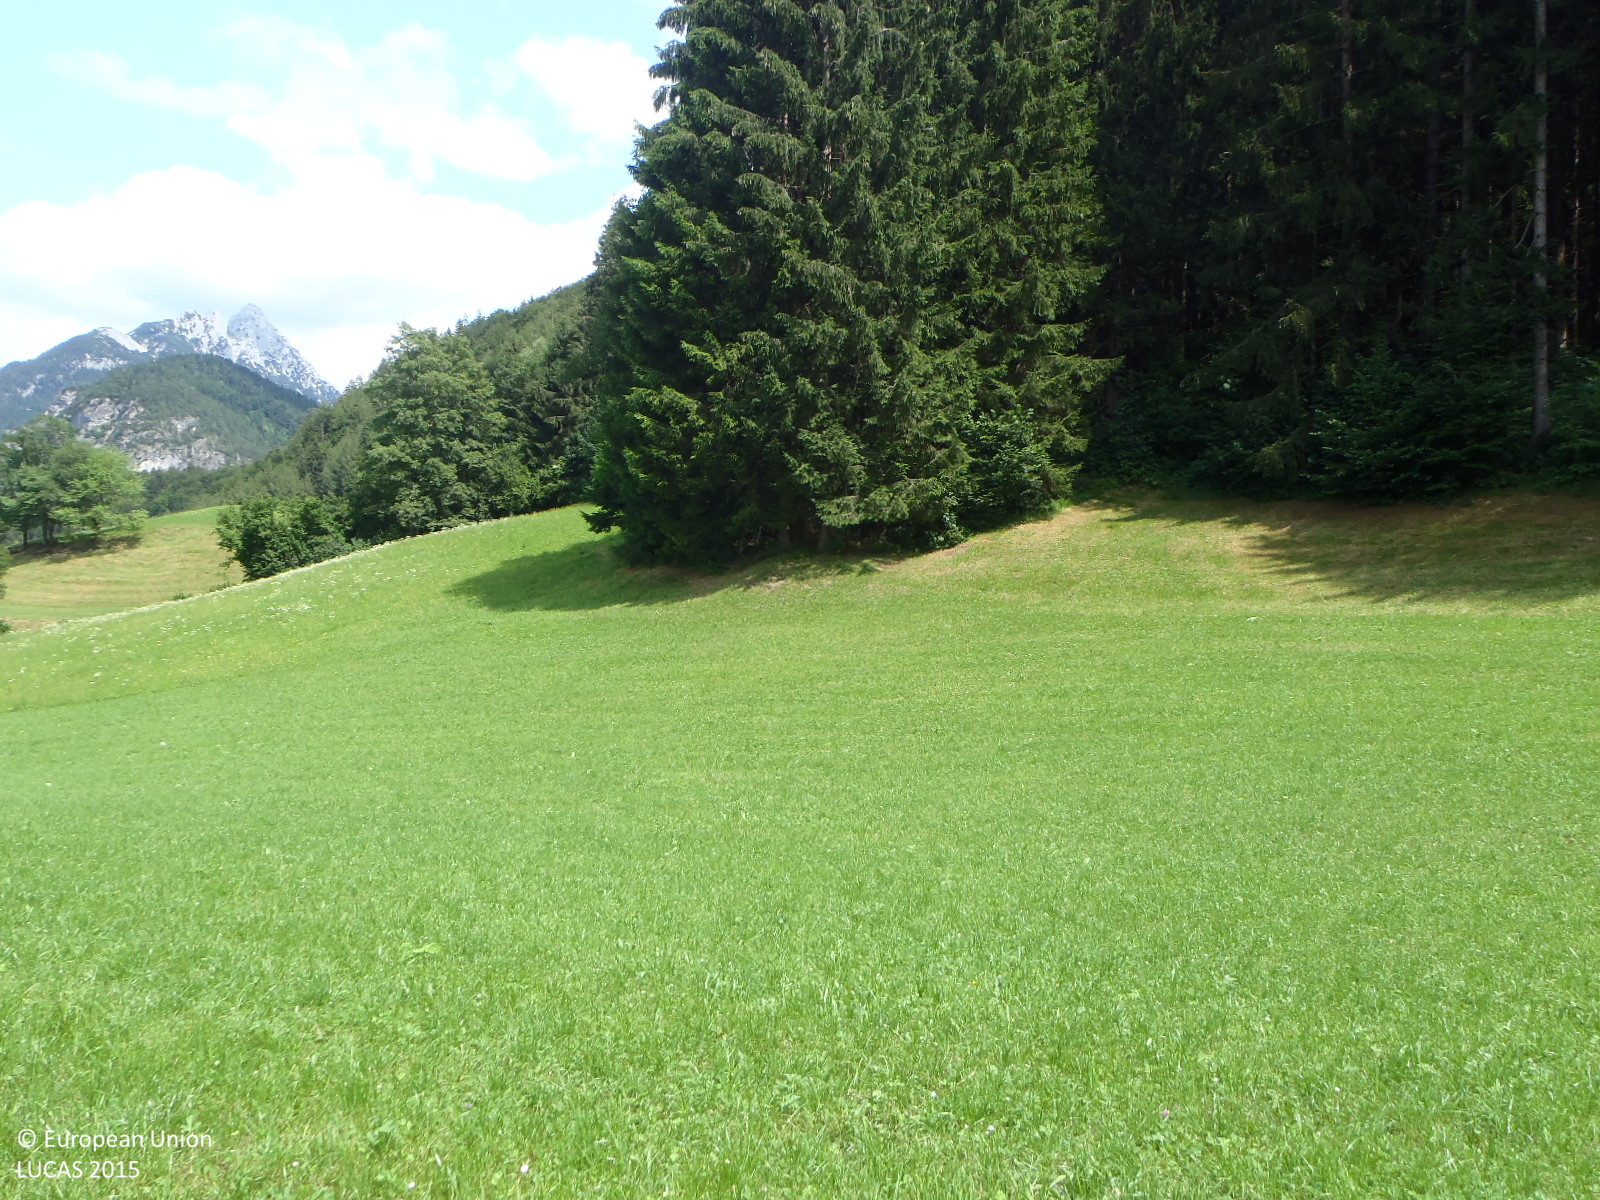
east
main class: Grassland
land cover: Grassland without tree/shrub cover
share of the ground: > 75 %
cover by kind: herbaceous plants 100 %
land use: Agriculture (excluding fallow land and kitchen gardens)
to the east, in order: Grassland without tree/shrub cover; Fences; Grassland without tree/shrub cover; Spruce dominated coniferous woodland; Grassland without tree/shrub cover; Spruce dominated mixed woodland; Grassland without tree/shrub cover; Spruce dominated mixed woodland; Spruce dominated coniferous woodland; Other coniferous woodland; Fences; Other mixed woodland; Ditches and canals; Other mixed woodland
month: July
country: AT
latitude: 47.5362
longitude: 12.1638
